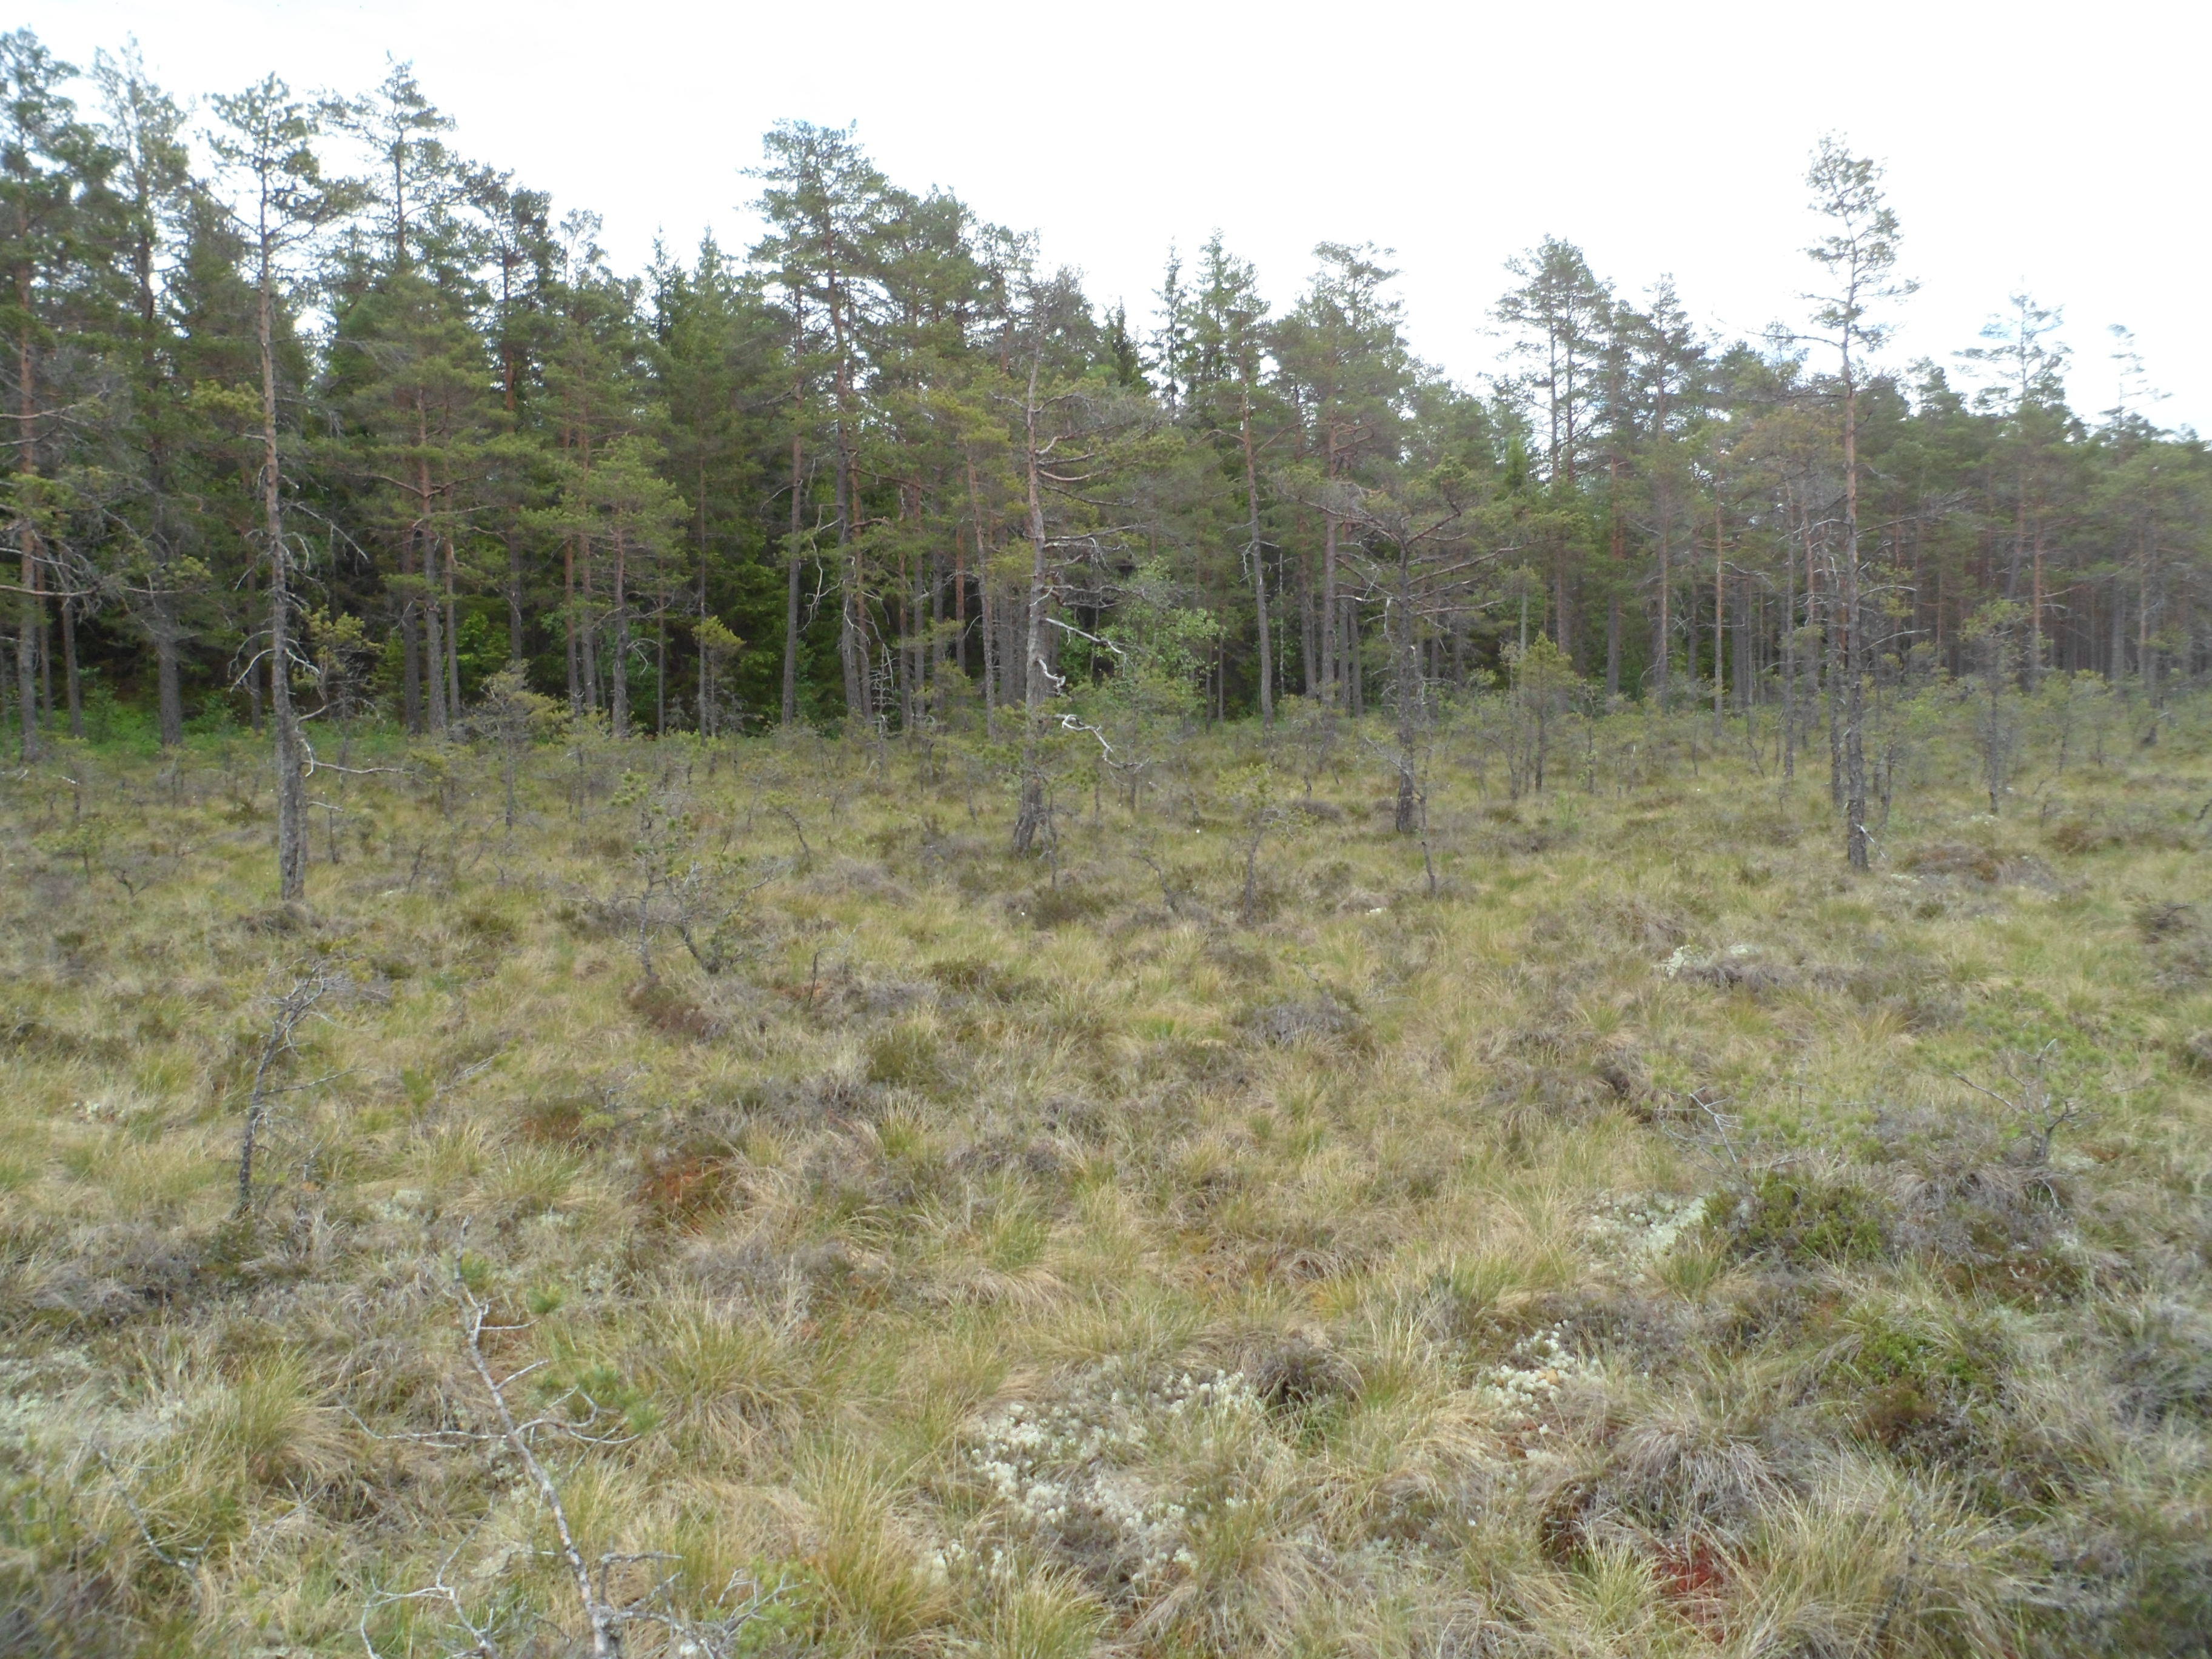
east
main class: Woodland
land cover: Pine dominated coniferous woodland
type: boreal forest
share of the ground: 10 - 25 %
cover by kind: herbaceous plants 40 %, lichens and mosses 35 %, coniferous forest trees 15 %, shrubs 10 %
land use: Amenities, museums, leisure
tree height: < 5 m
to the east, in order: Pine dominated coniferous woodland; Ditches and canals; Spruce dominated coniferous woodland; Tracks; Spruce dominated coniferous woodland; Ditches and canals; Pine dominated coniferous woodland
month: June
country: SE
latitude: 57.3908
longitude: 14.4048
